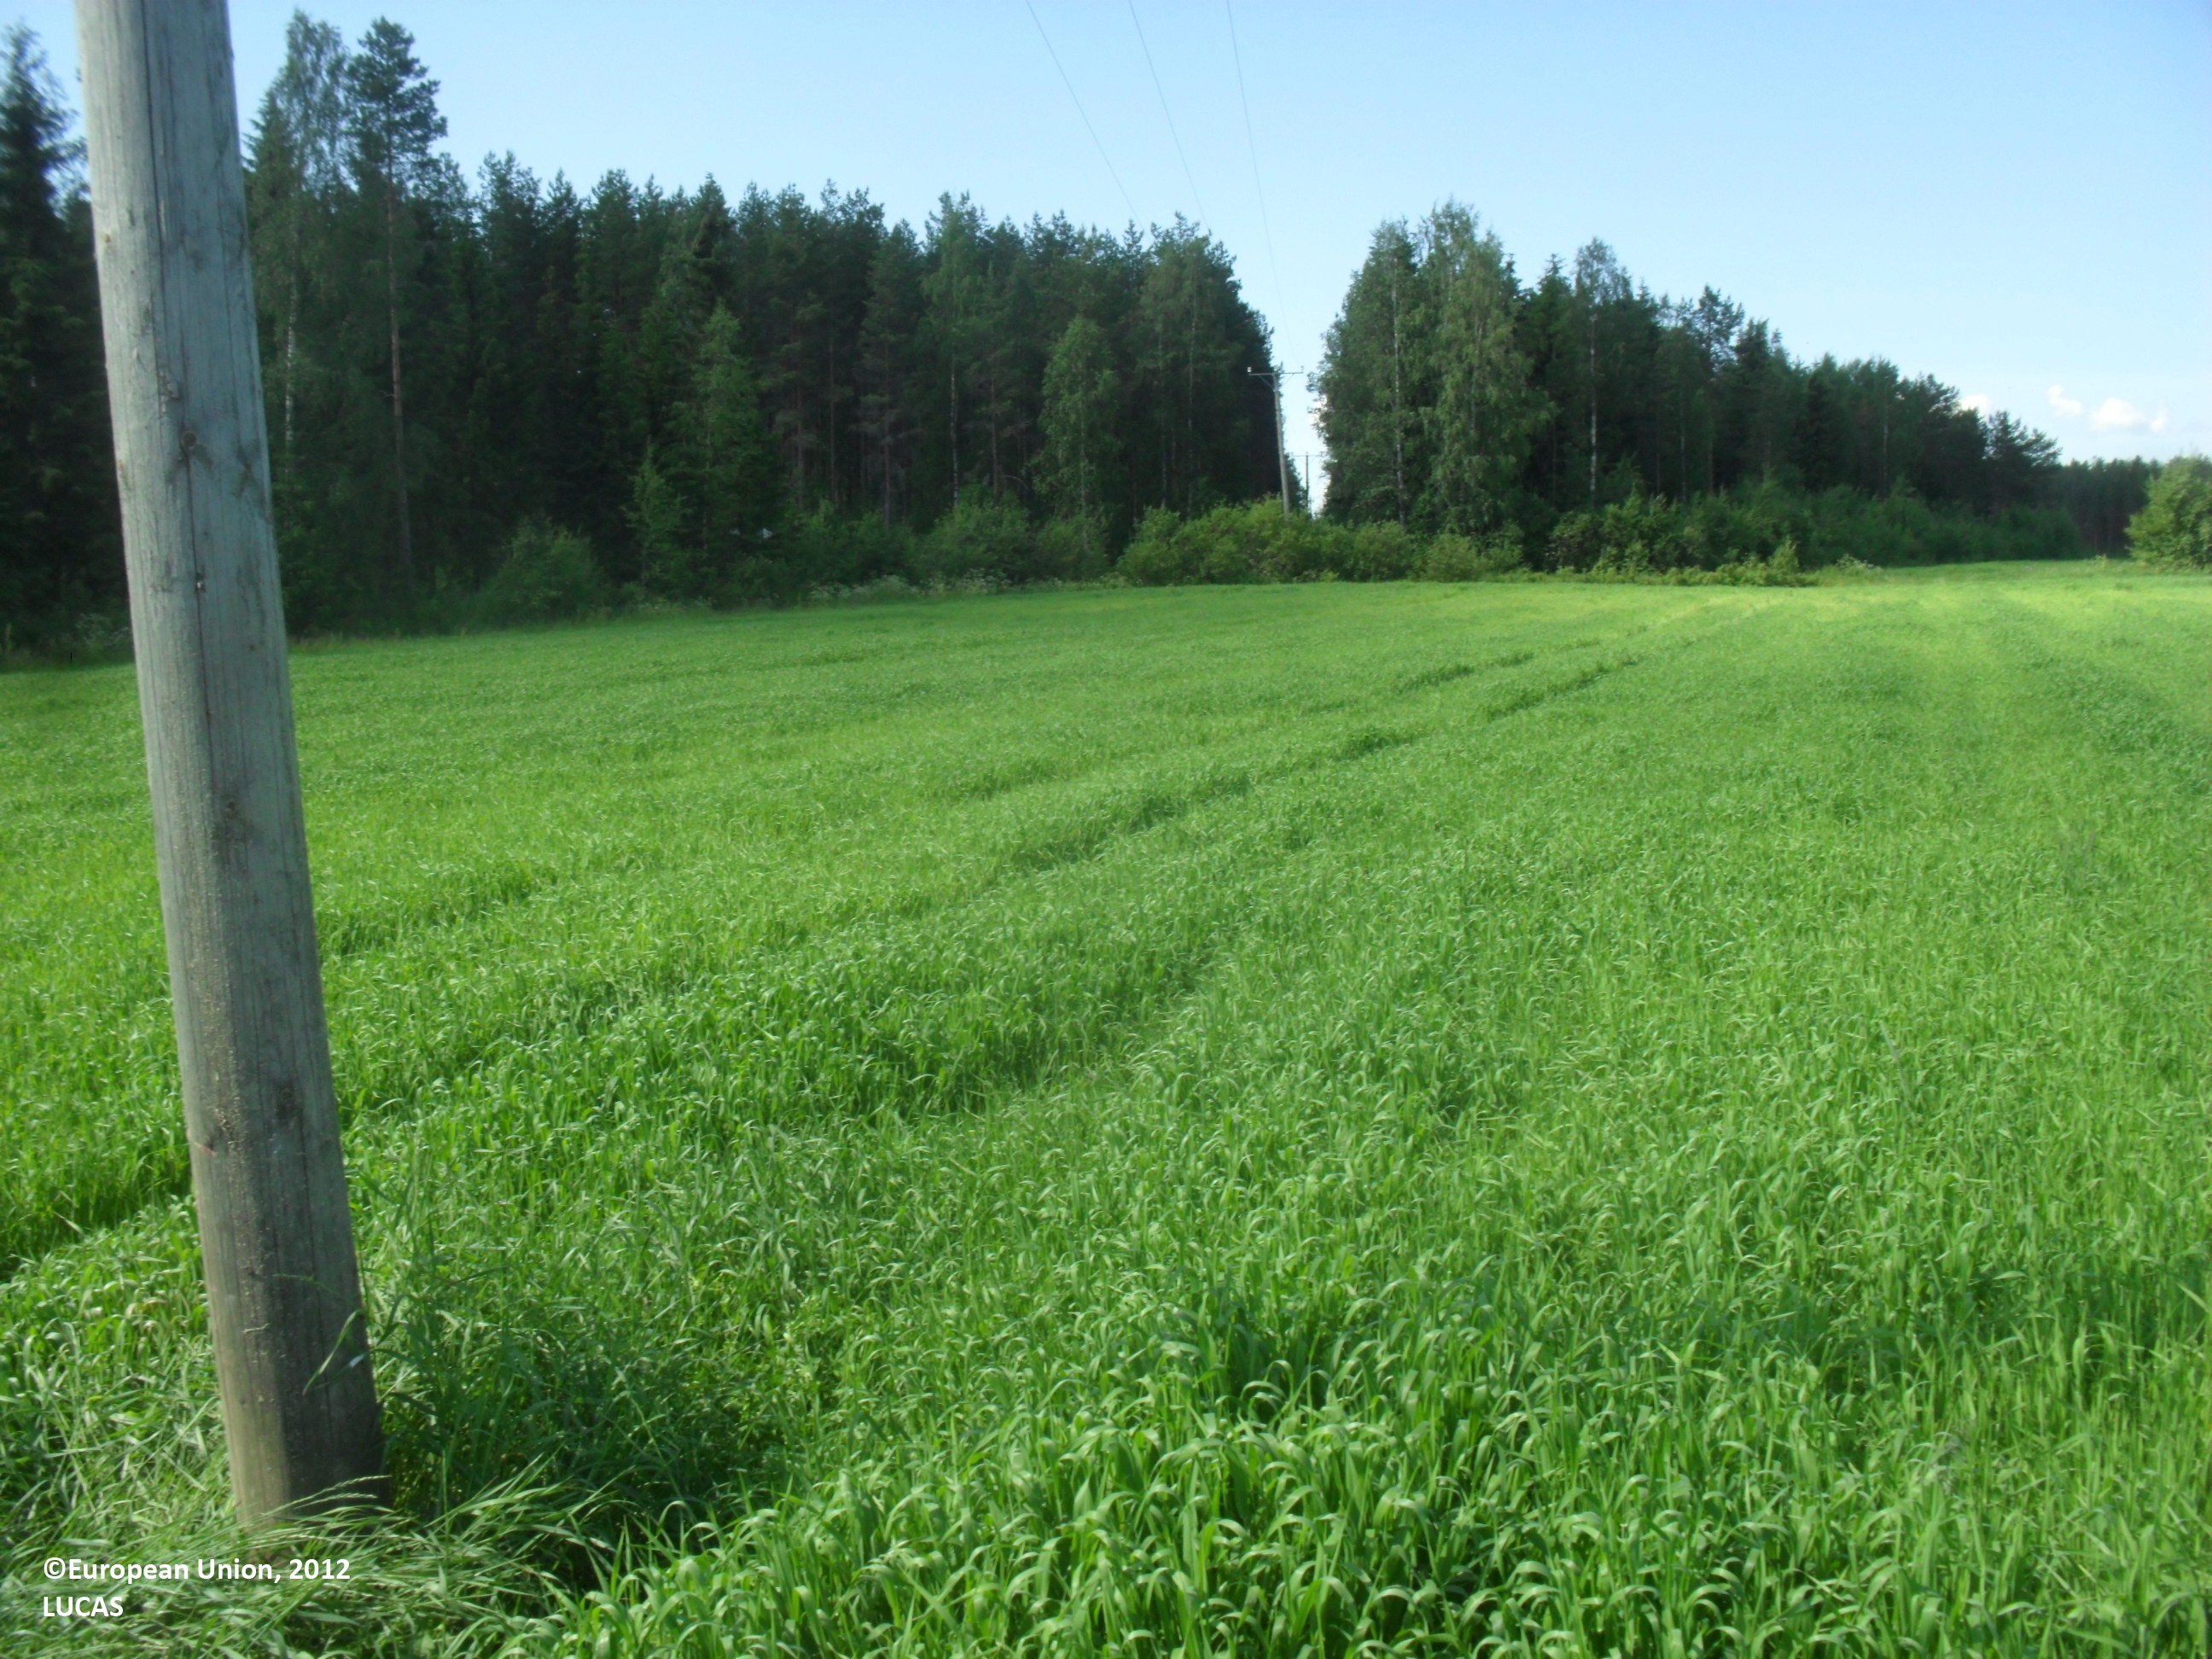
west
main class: Cropland
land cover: Oats
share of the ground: > 75 %
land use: Agriculture (excluding fallow land and kitchen gardens)
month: July
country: FI
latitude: 63.3047
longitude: 23.8972
